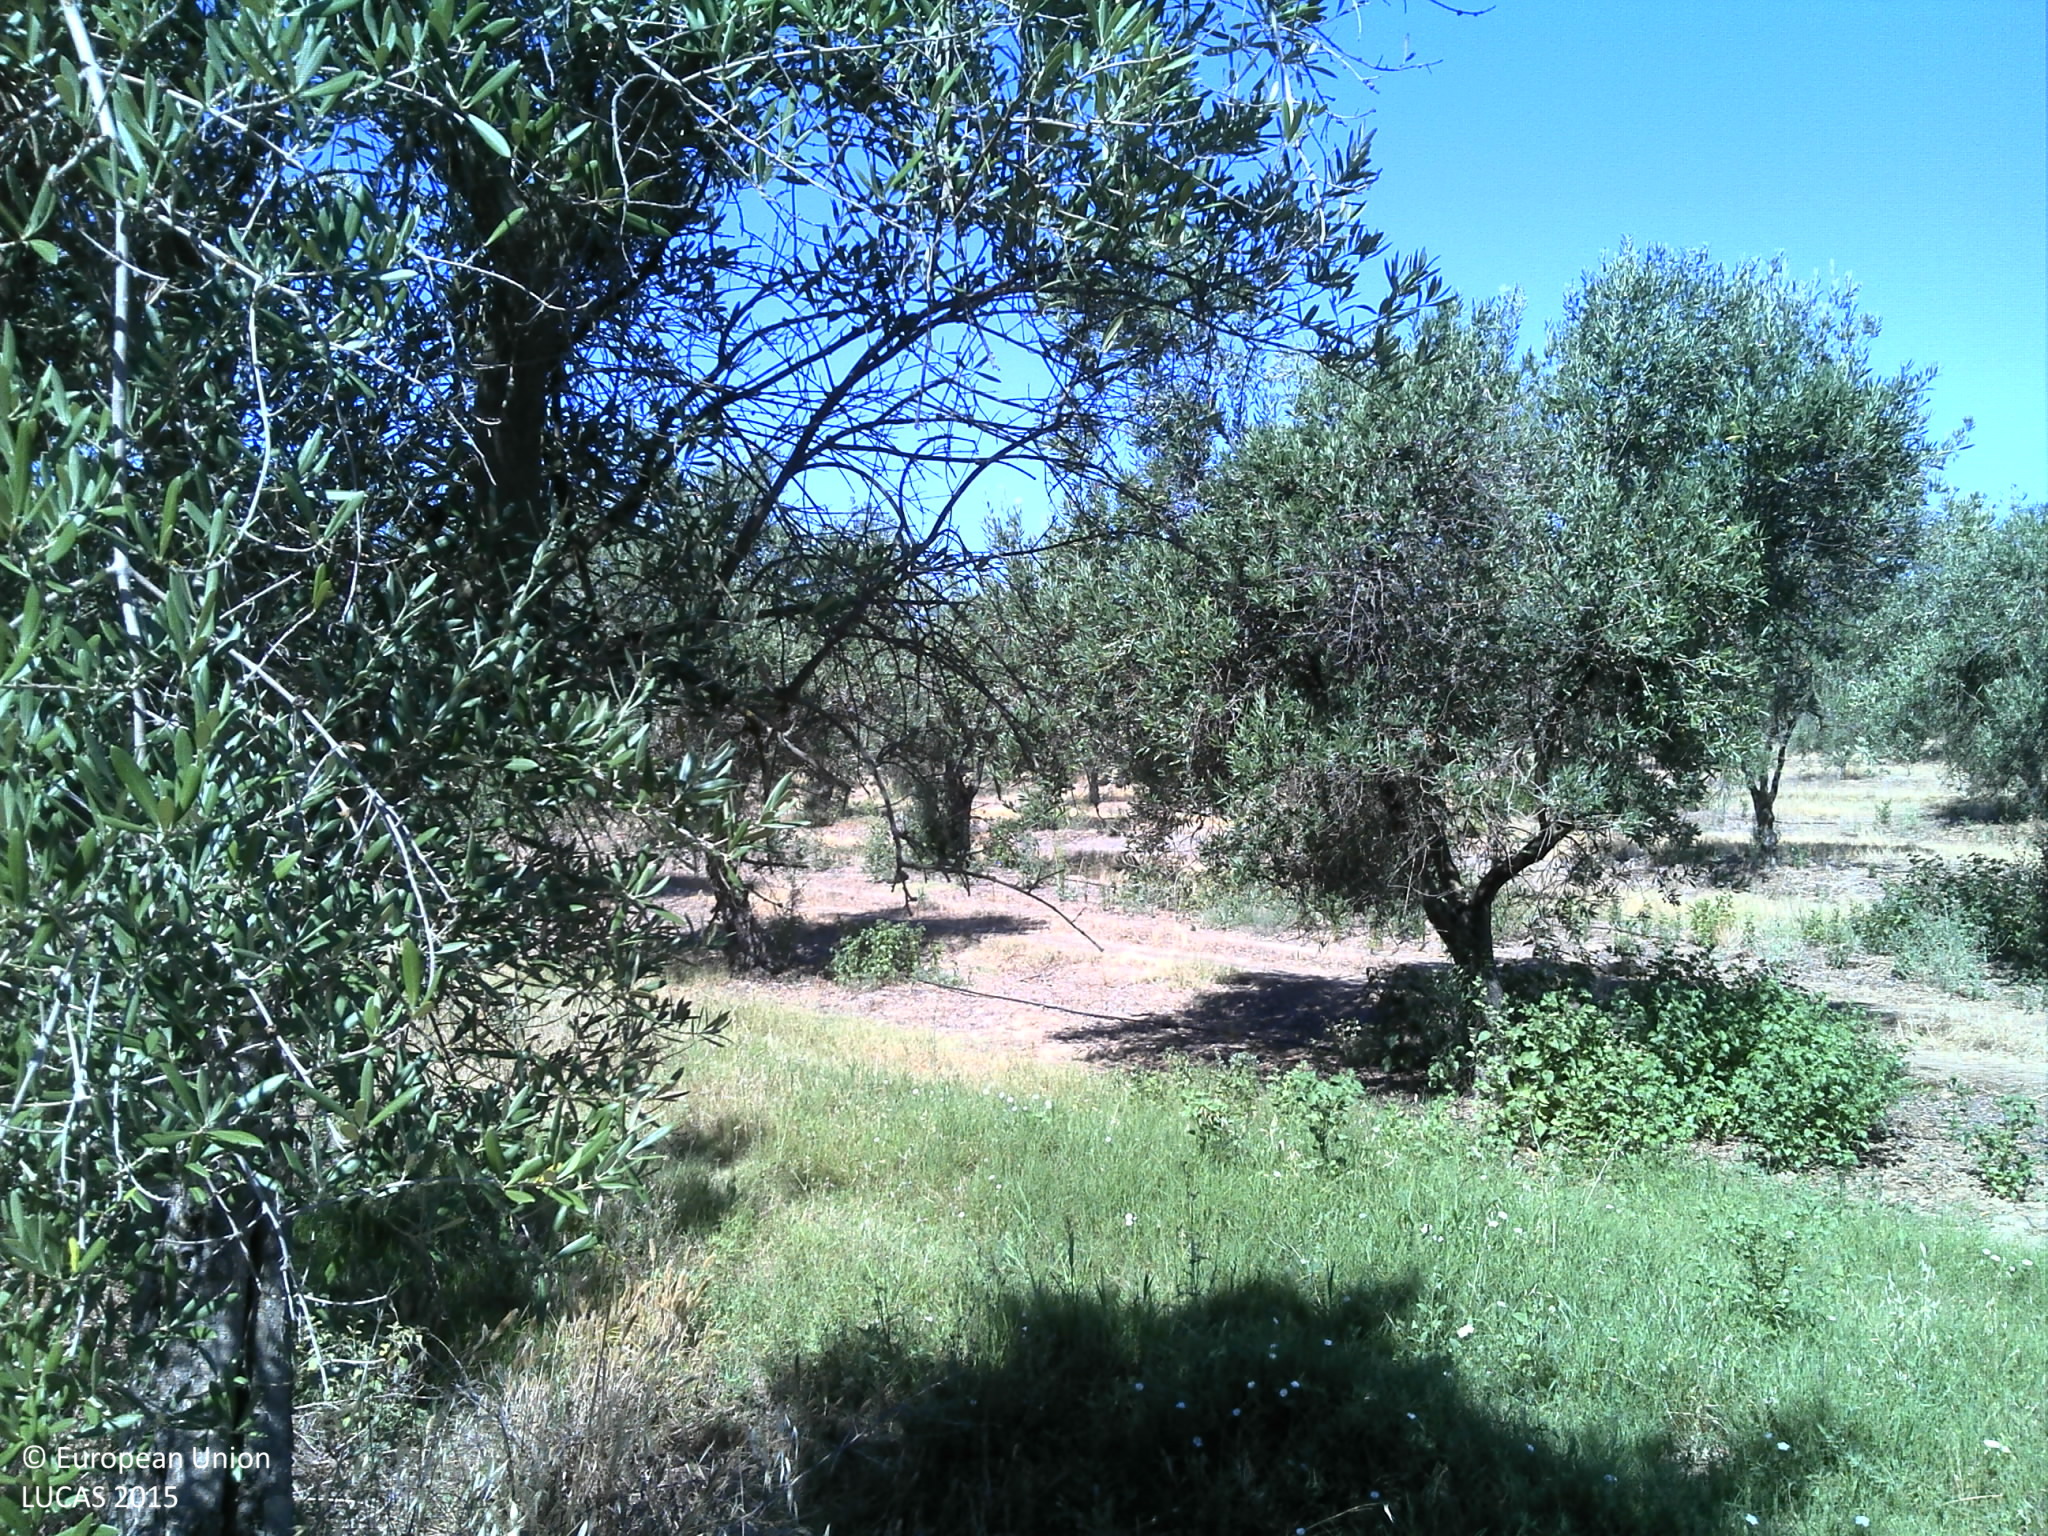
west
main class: Cropland
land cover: Olive groves
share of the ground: 25 - 50 %
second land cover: Grassland without tree/shrub cover
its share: > 75 %
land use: Agriculture (excluding fallow land and kitchen gardens)
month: July
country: PT
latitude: 38.9312
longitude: -7.4423
